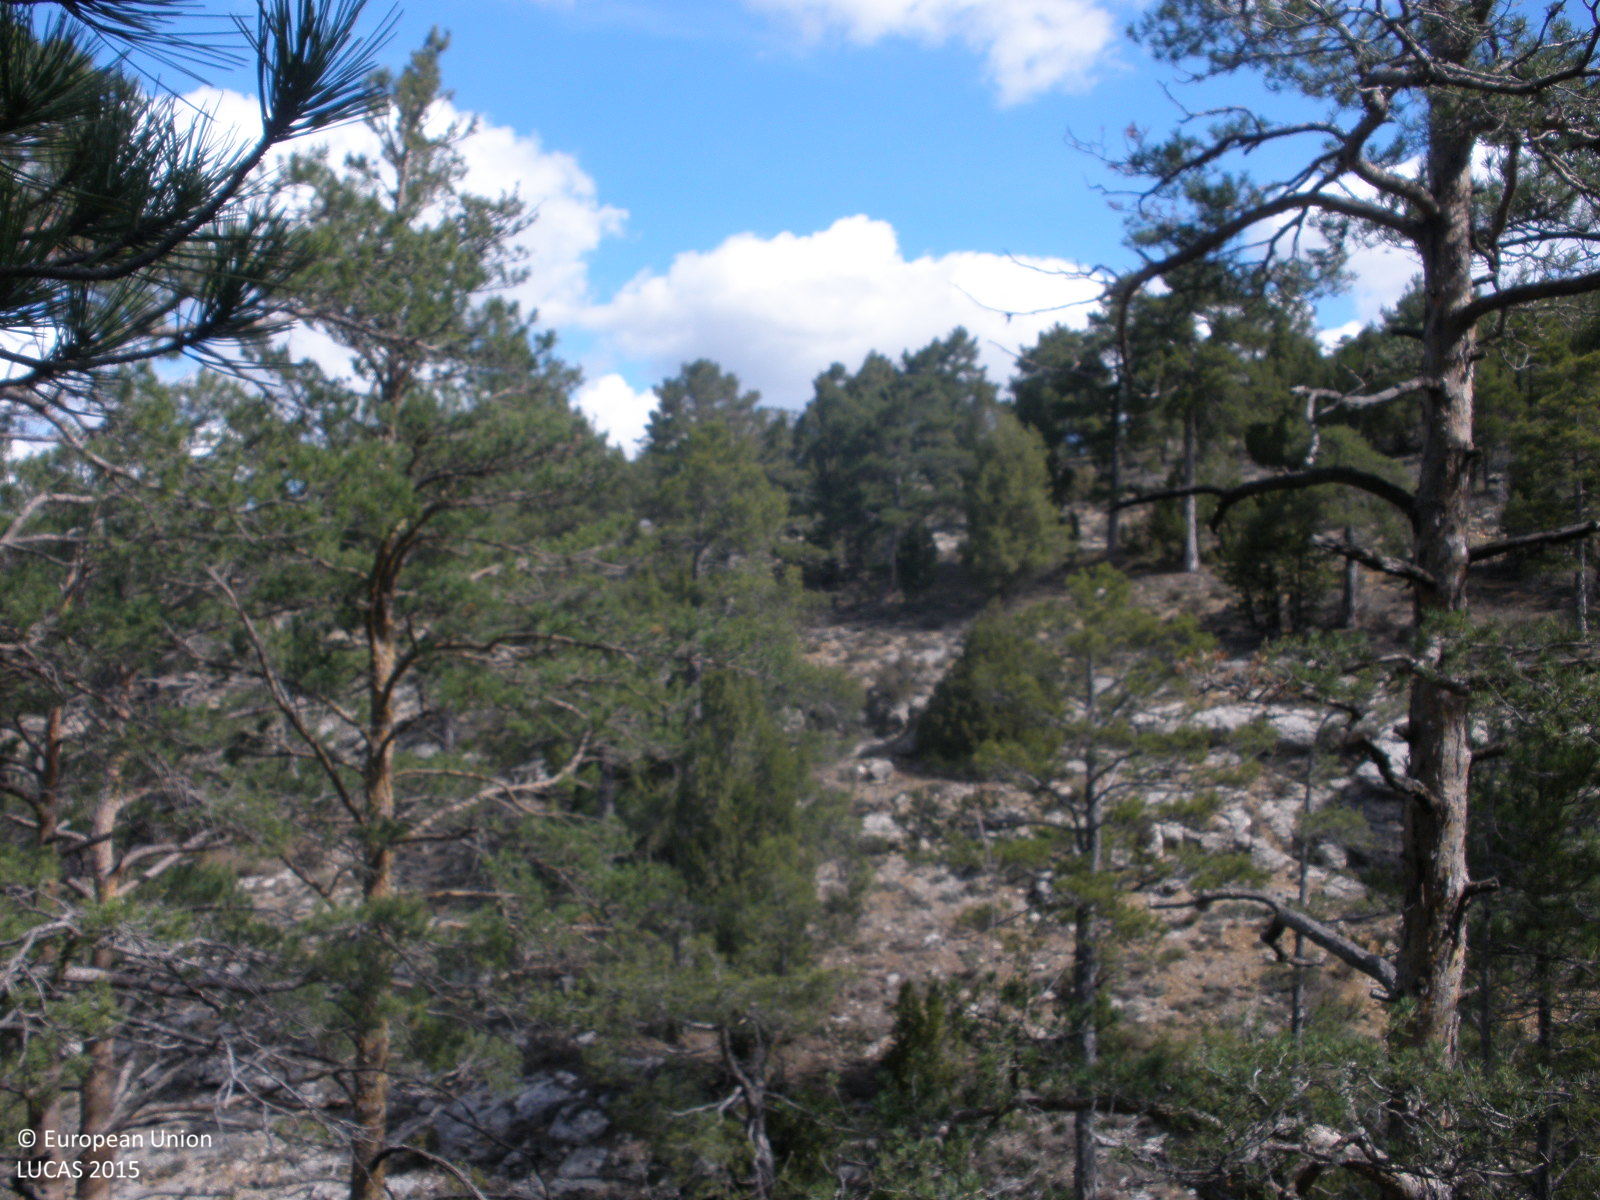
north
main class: Woodland
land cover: Pine dominated coniferous woodland
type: coniferous forest of the mediterranean region
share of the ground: > 75 %
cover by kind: coniferous forest trees 75 %, shrubs 15 %, herbaceous plants 10 %
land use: Semi-natural and natural areas not in use
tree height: > 5 m
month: April
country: ES
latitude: 40.3513
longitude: -0.7342
